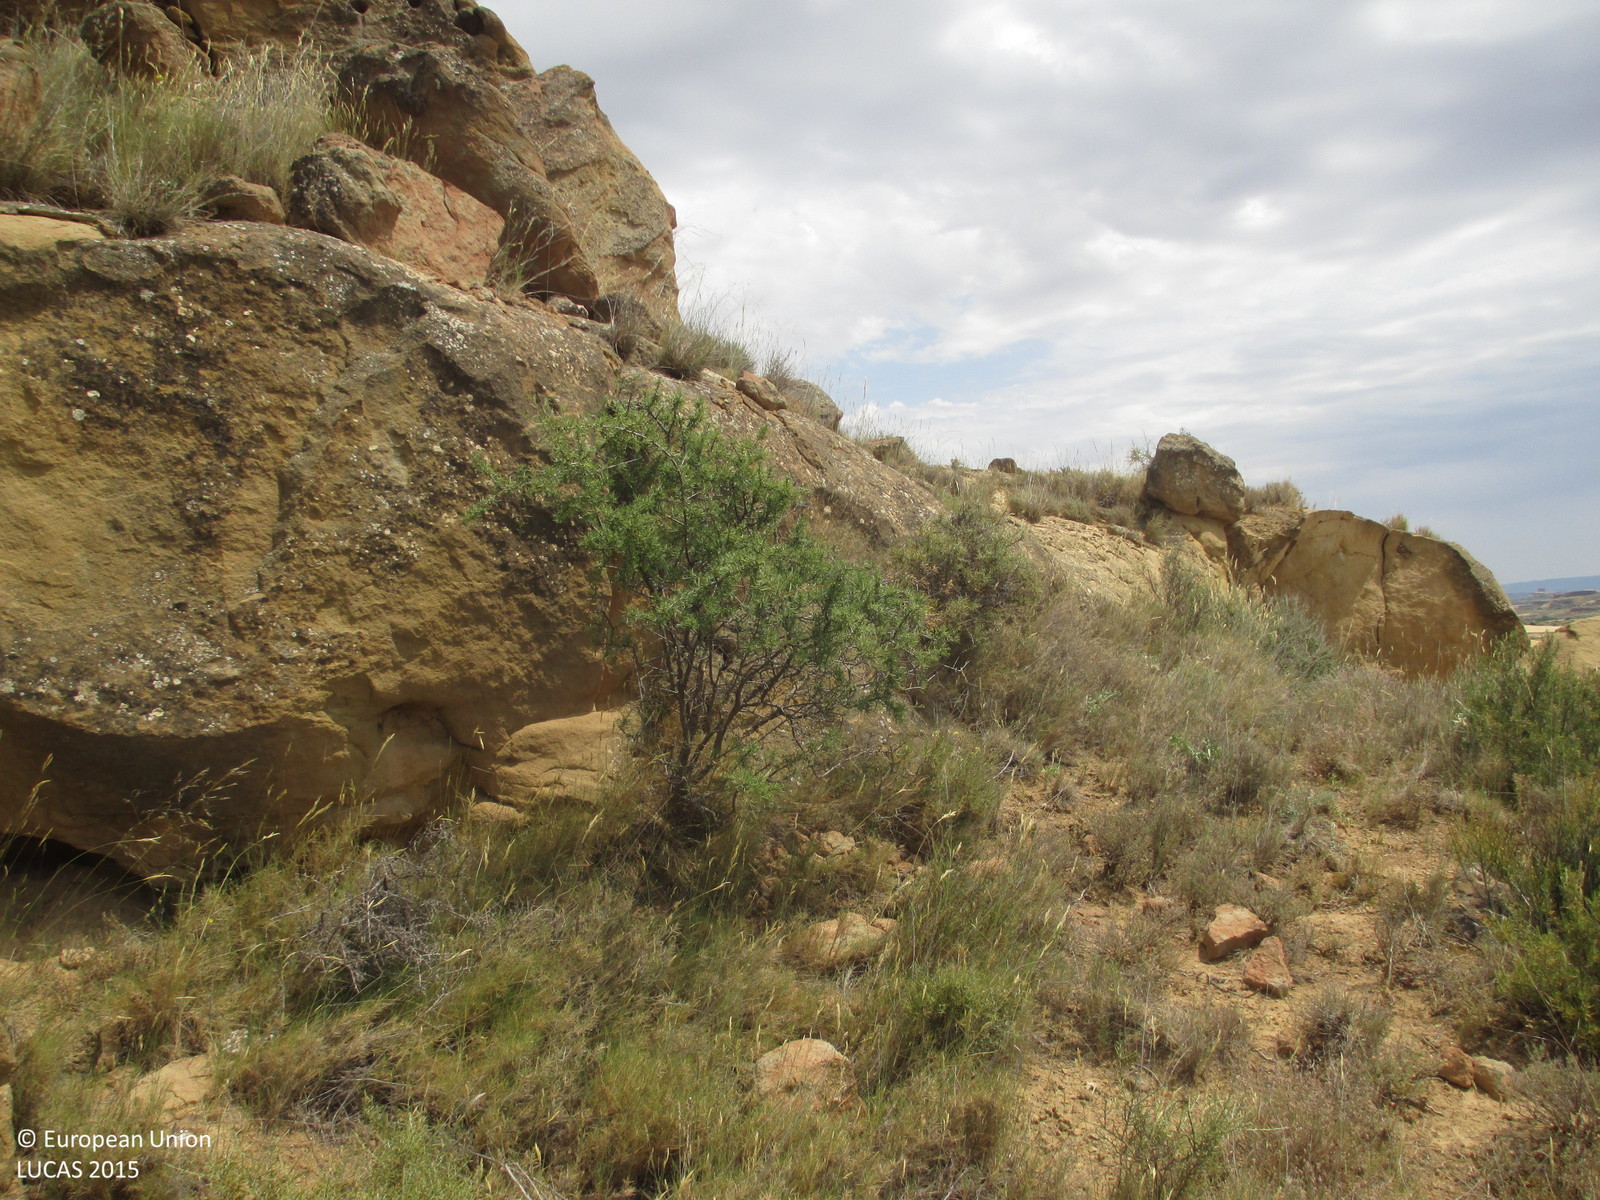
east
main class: Shrubland
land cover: Shrubland without tree cover
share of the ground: > 75 %
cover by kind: shrubs 90 %, herbaceous plants 10 %
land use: Semi-natural and natural areas not in use
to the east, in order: Shrubland without tree cover; Rock outcrops; Shrubland without tree cover; Tracks; Shrubland without tree cover; Inland fresh running water; Shrubland without tree cover; Barley; Shrubland without tree cover; Rock outcrops; Shrubland without tree cover; Rock outcrops; Shrubland without tree cover
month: May
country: ES
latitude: 41.9341
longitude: -0.2348
